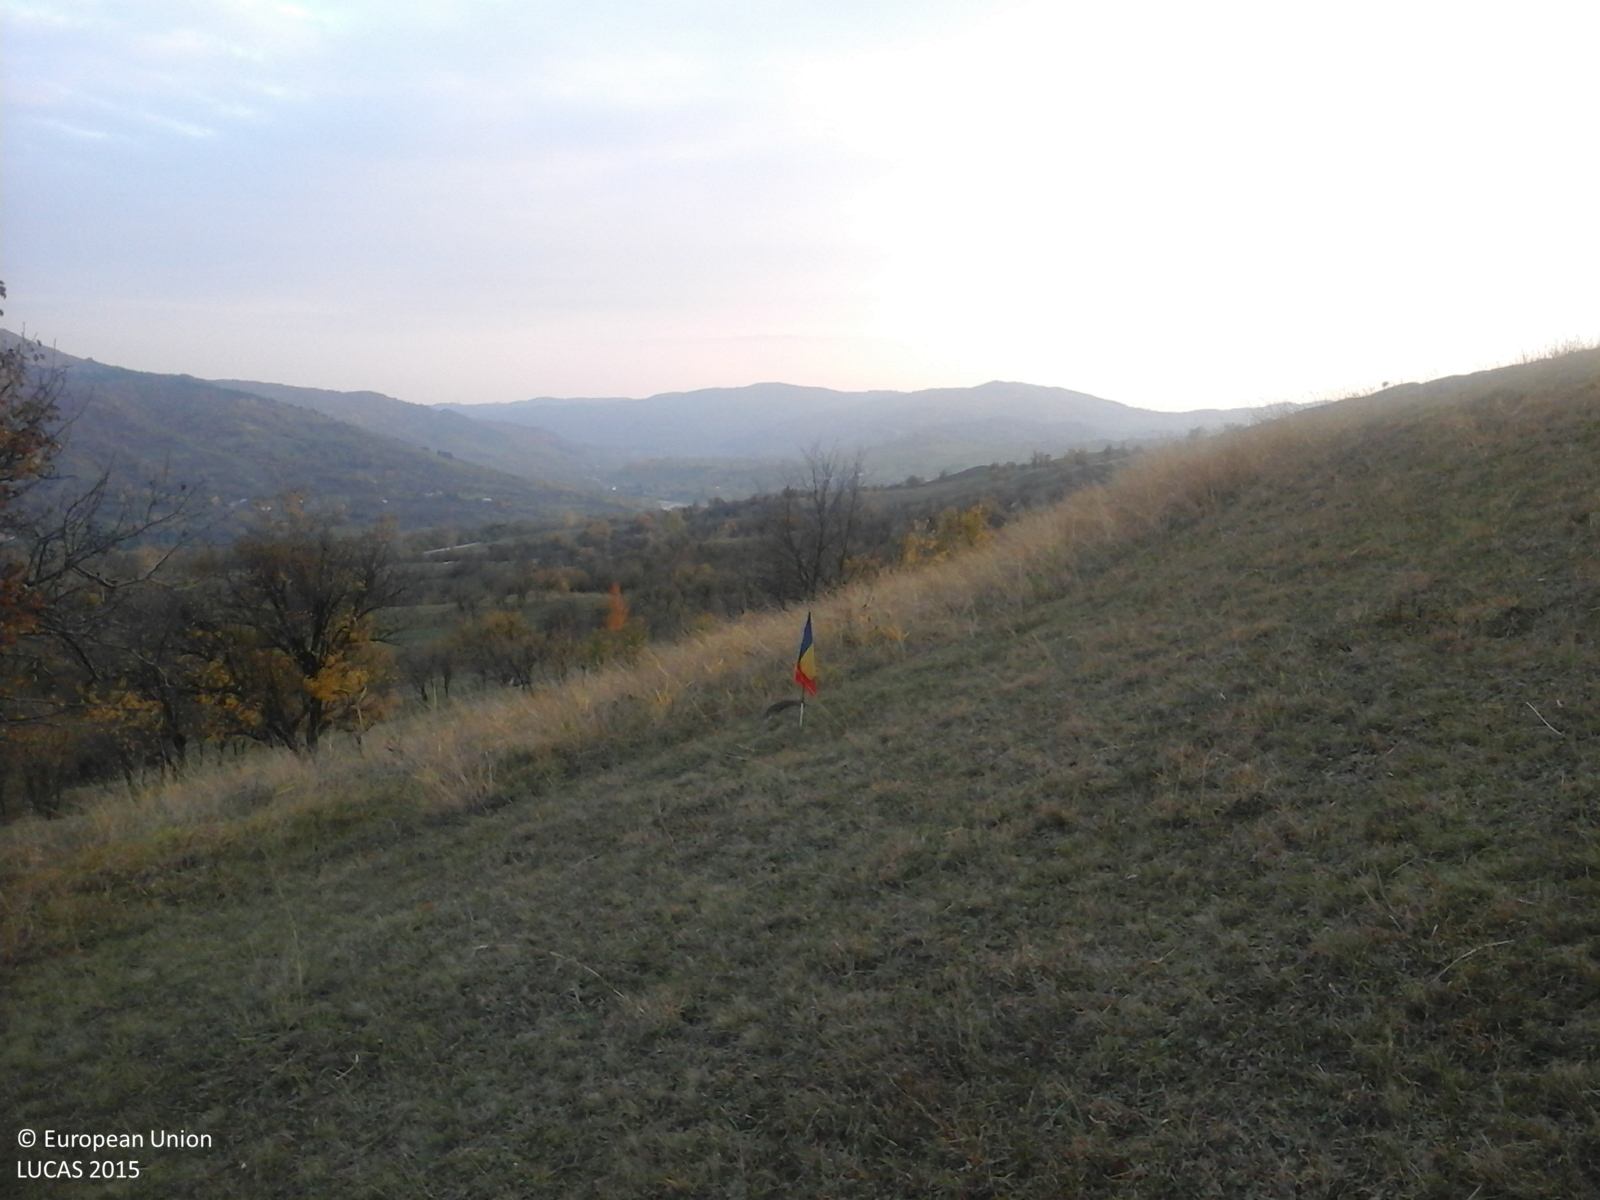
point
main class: Grassland
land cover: Grassland with sparse tree/shrub cover
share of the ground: > 75 %
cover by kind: herbaceous plants 95 %, broadleaved forest trees 5 %
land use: Agriculture (excluding fallow land and kitchen gardens)
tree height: > 5 m
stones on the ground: < 10 %
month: October
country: RO
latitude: 45.4779
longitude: 26.7496
